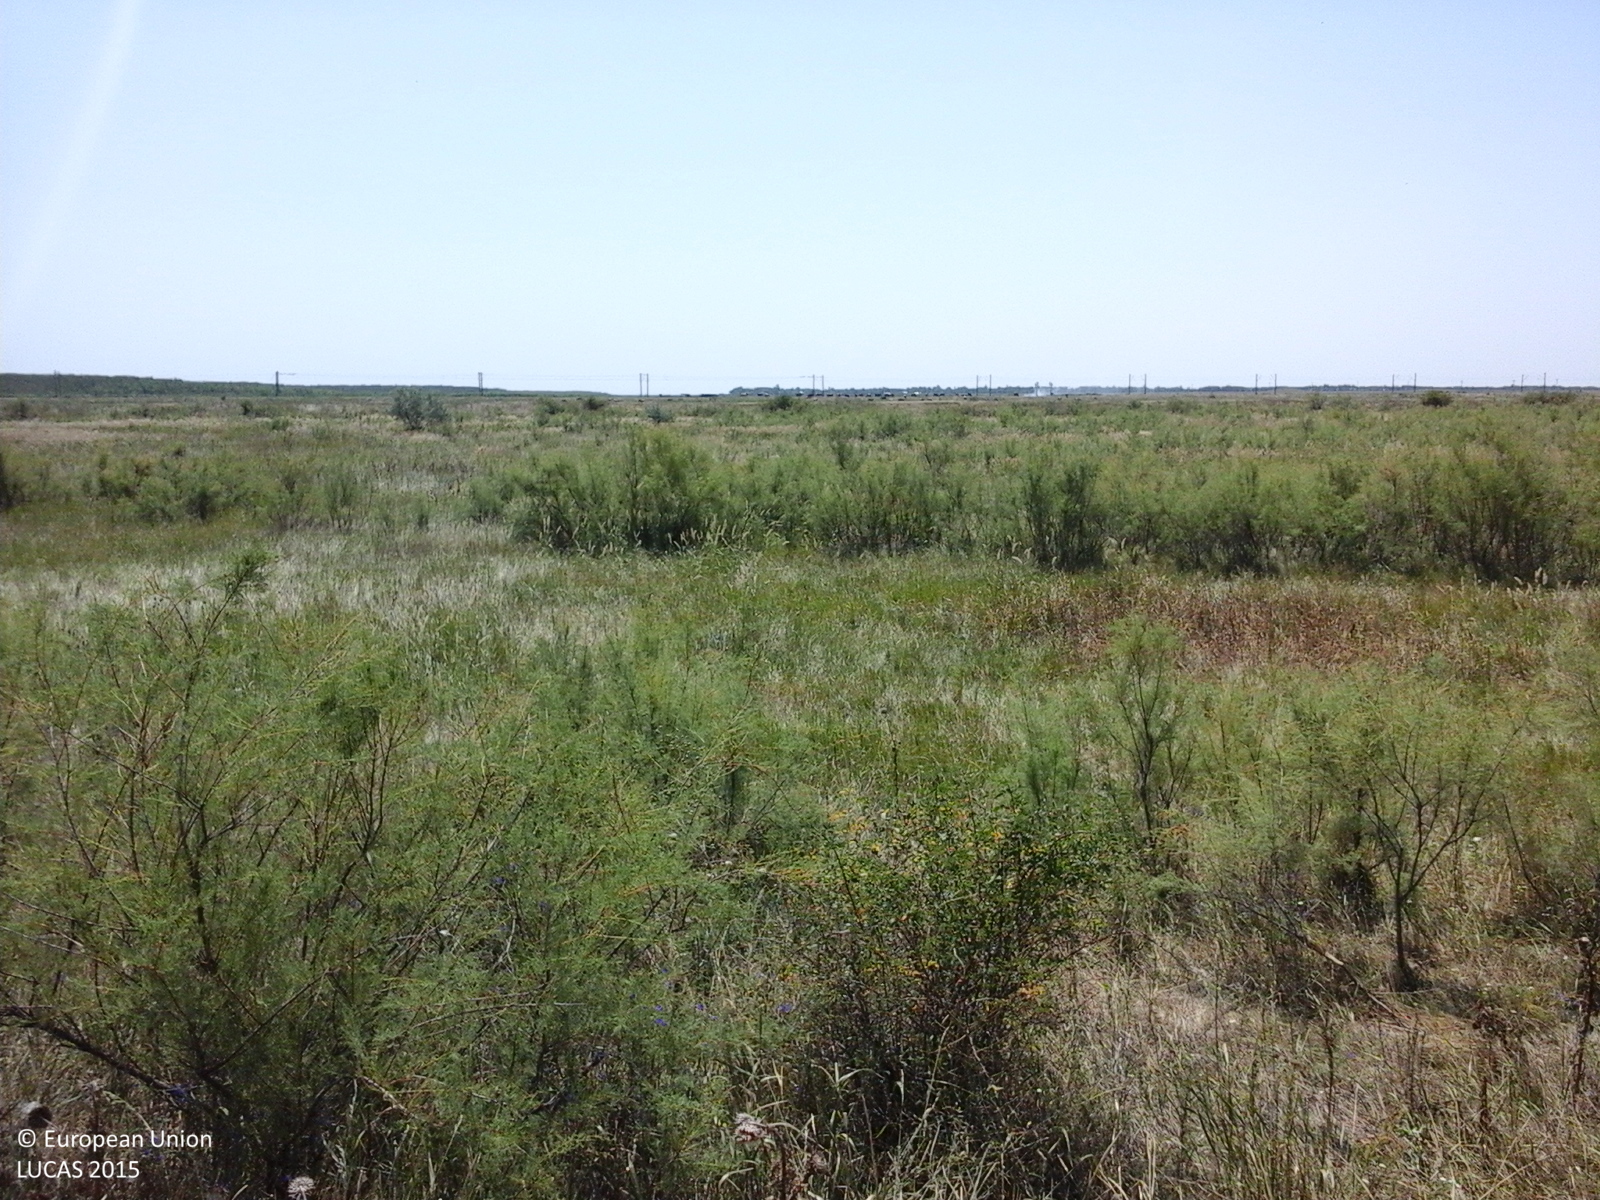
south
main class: Grassland
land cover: Spontaneously vegetated surfaces
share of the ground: > 75 %
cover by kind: herbaceous plants 100 %
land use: Fallow land
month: July
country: RO
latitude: 45.0733
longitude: 27.1993
